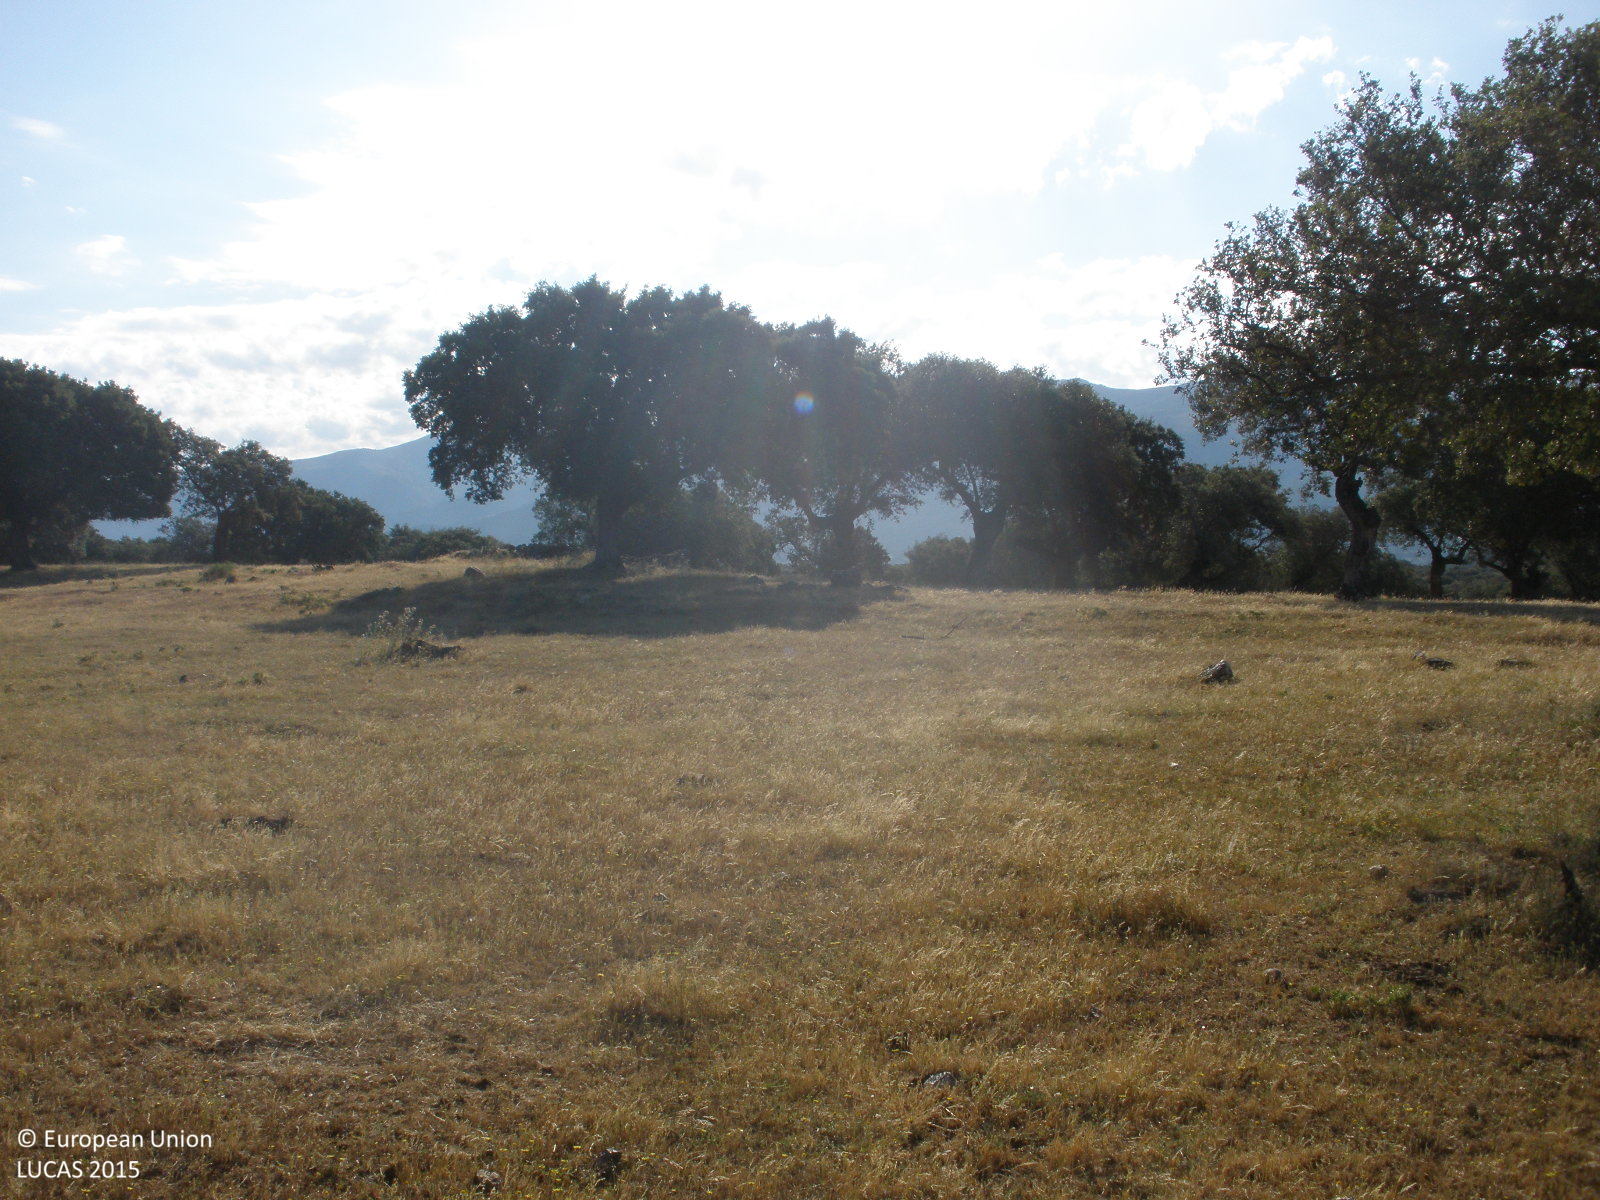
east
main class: Woodland
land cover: Broadleaved woodland
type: broadleaved evergreen forest
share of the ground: 25 - 50 %
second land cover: Grassland without tree/shrub cover
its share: > 75 %
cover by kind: herbaceous plants 70 %, broadleaved forest trees 30 %
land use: Forestry
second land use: Agriculture (excluding fallow land and kitchen gardens)
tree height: > 5 m
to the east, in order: Broadleaved woodland; Grassland without tree/shrub cover
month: May
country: ES
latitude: 40.1685
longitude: -6.0541
